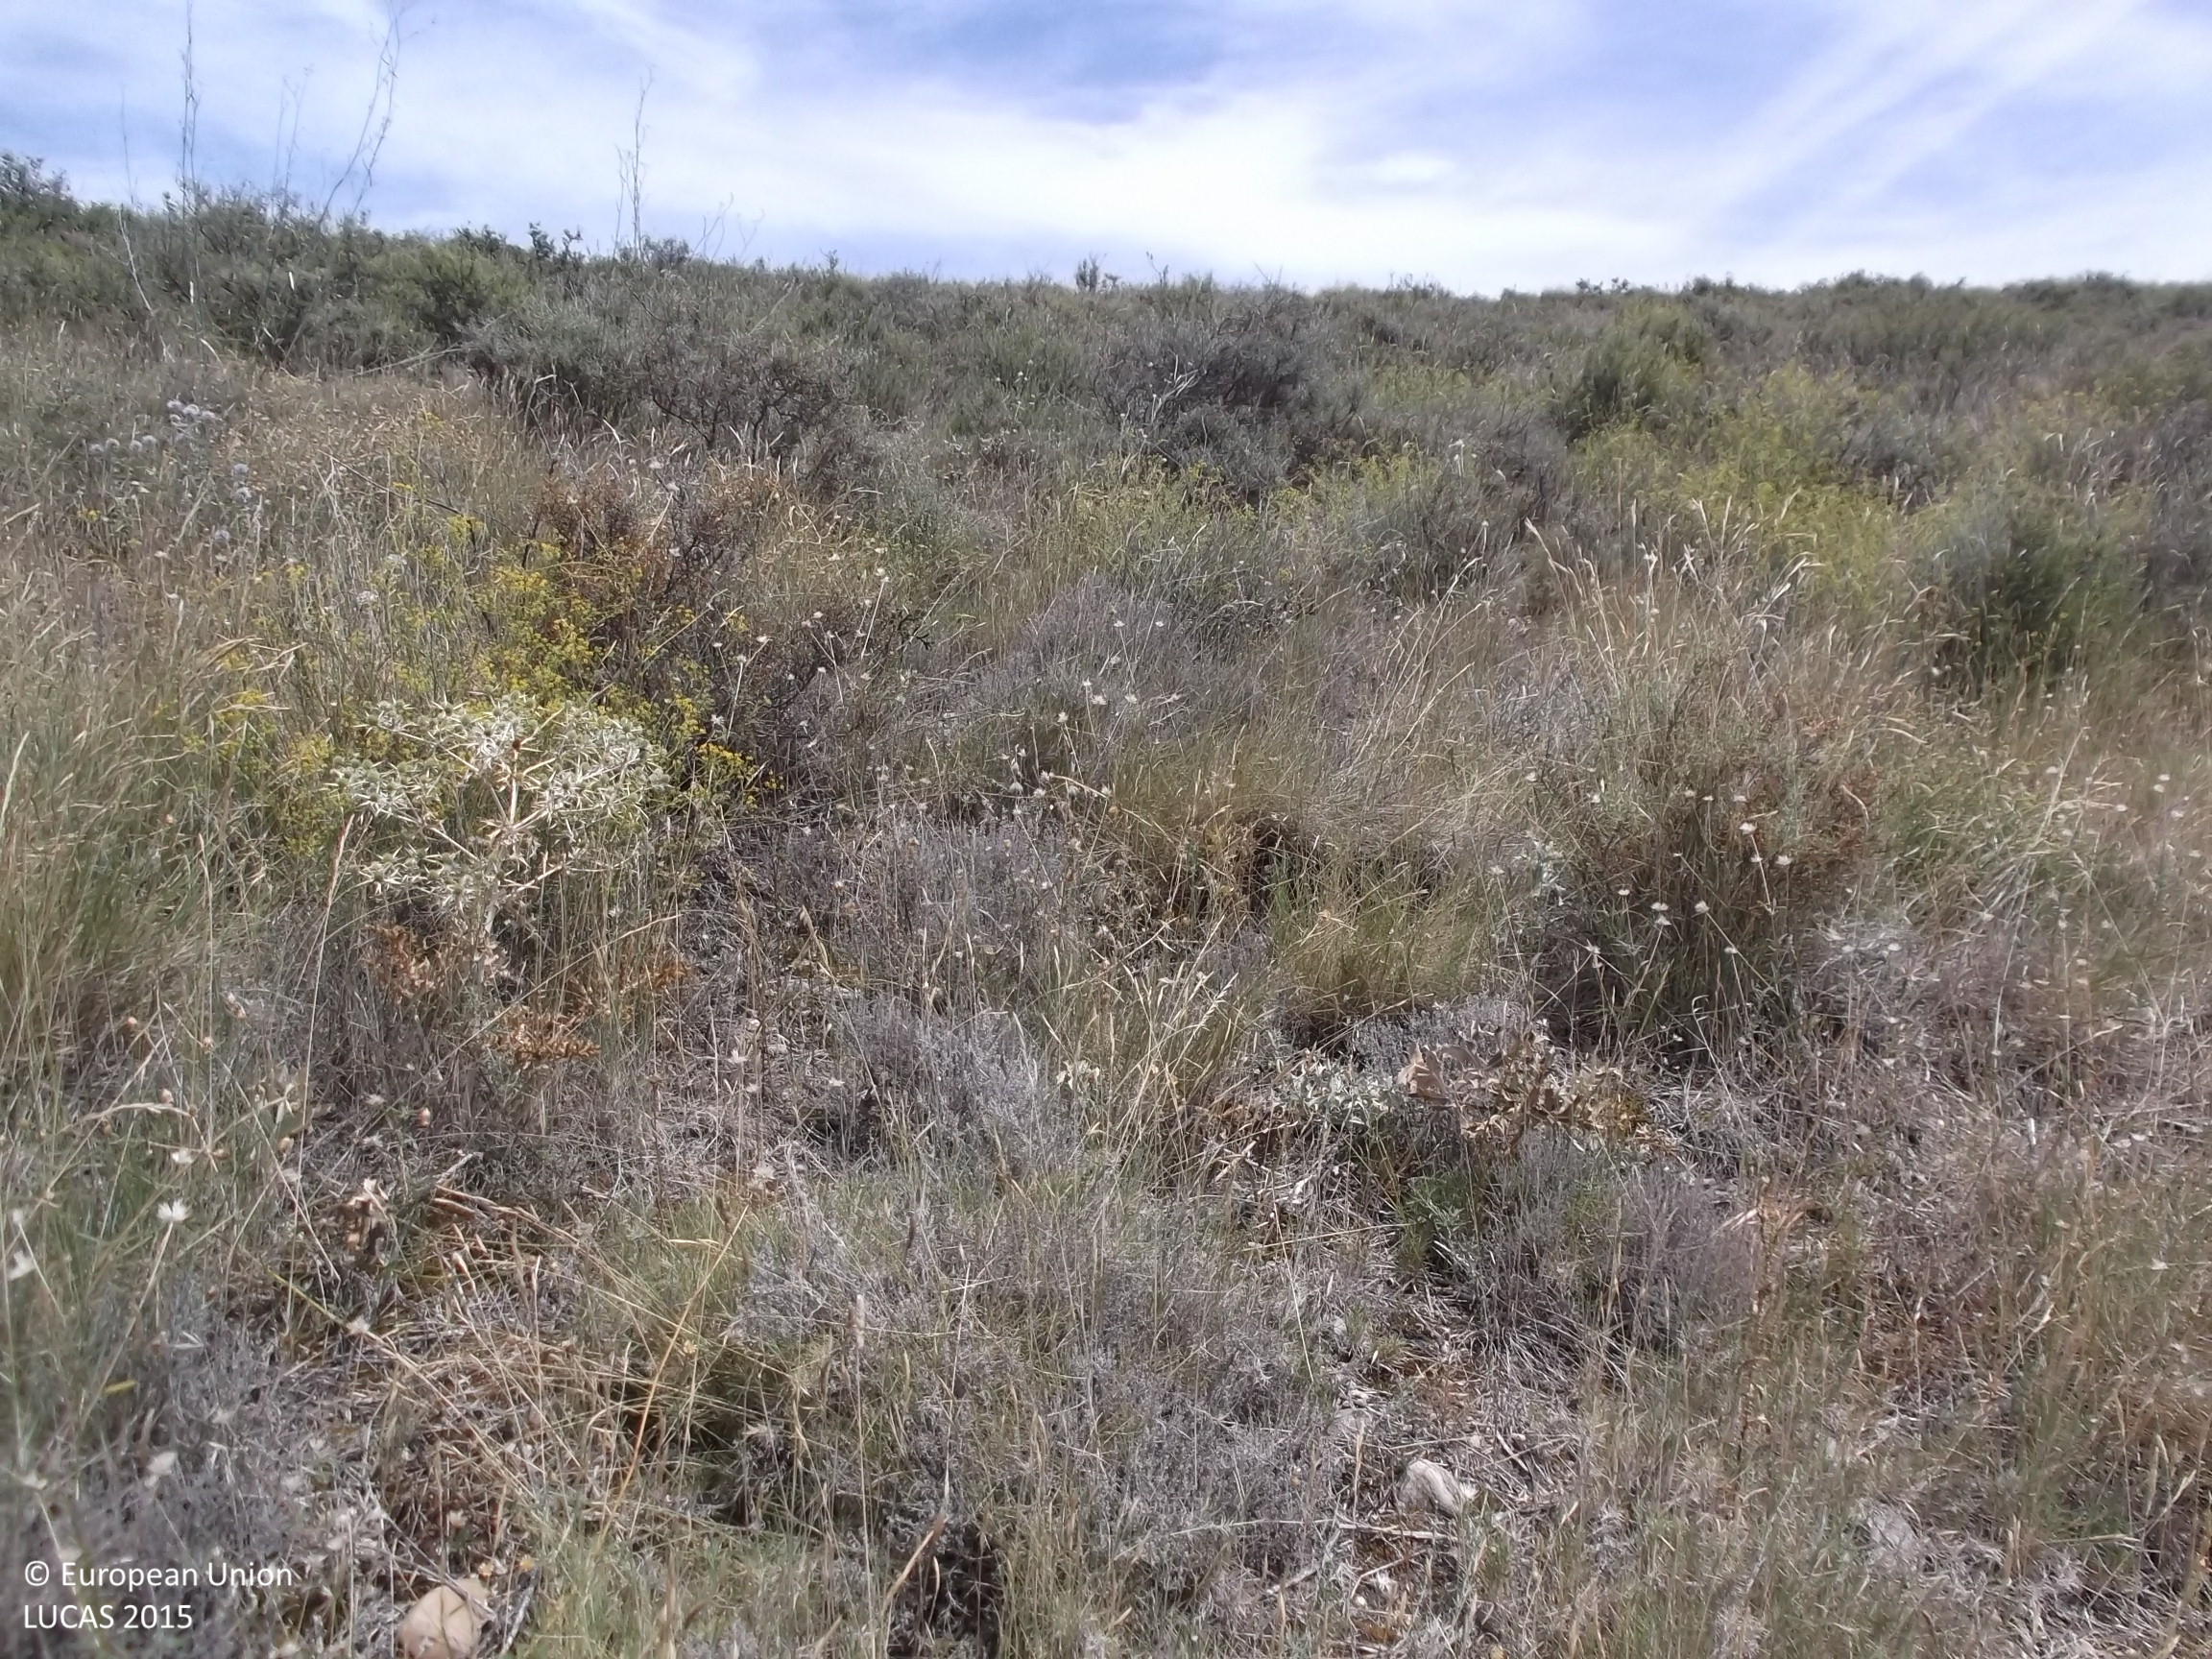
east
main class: Shrubland
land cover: Shrubland without tree cover
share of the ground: 50 - 75 %
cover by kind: shrubs 60 %, herbaceous plants 30 %, lichens and mosses 5 %
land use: Semi-natural and natural areas not in use
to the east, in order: Shrubland without tree cover; Rye; Shrubland without tree cover
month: August
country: ES
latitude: 42.4620
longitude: -2.1908
